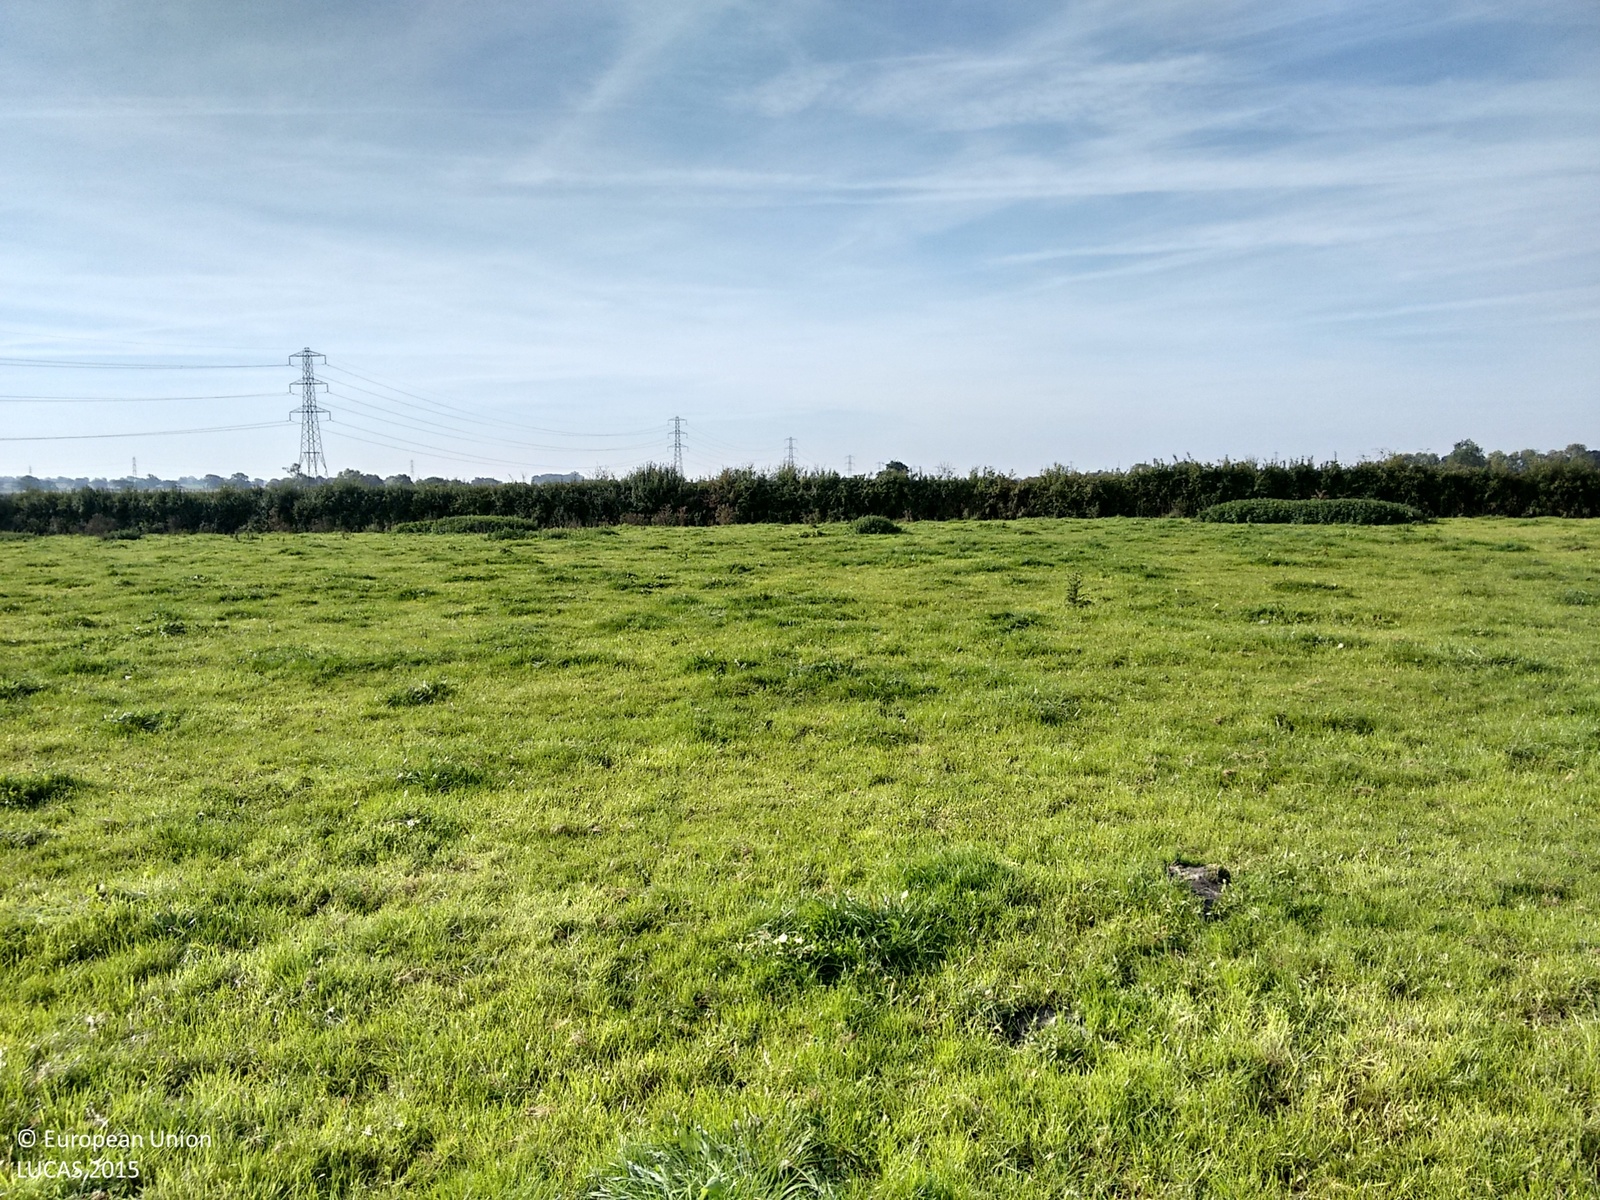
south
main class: Grassland
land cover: Grassland without tree/shrub cover
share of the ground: > 75 %
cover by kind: herbaceous plants 100 %
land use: Agriculture (excluding fallow land and kitchen gardens)
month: September
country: GB
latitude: 51.5899
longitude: -2.4647
